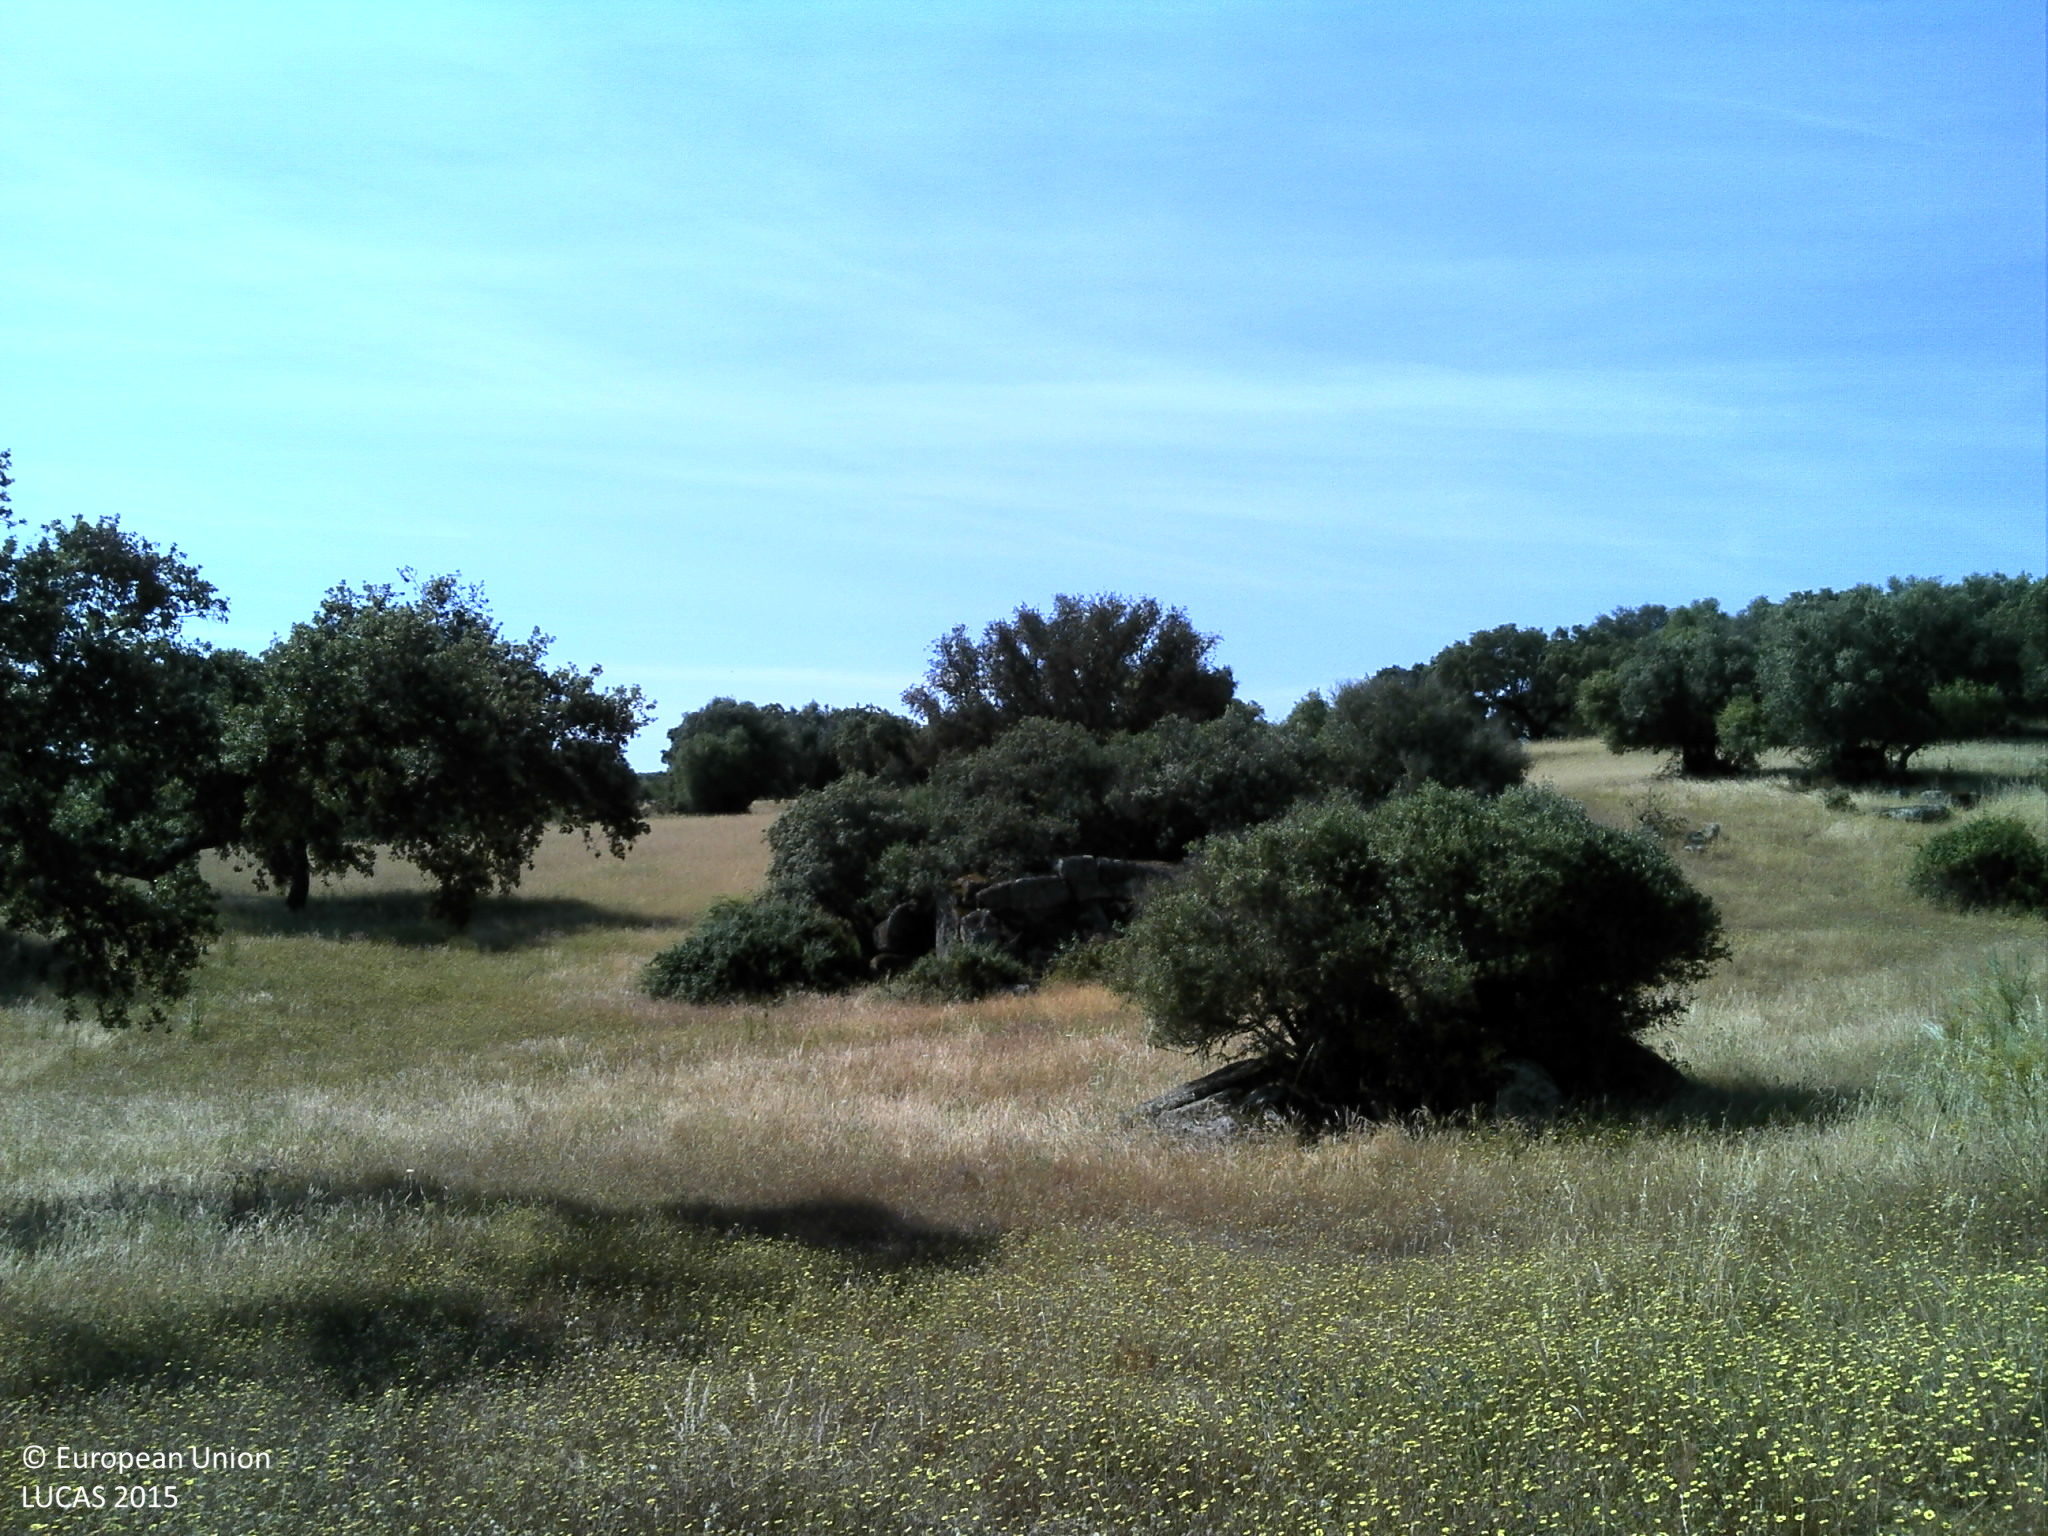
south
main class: Cropland
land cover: Olive groves
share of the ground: 10 - 25 %
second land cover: Triticale
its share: 10 - 25 %
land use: Agriculture (excluding fallow land and kitchen gardens)
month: May
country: PT
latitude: 39.0512
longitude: -7.5930
